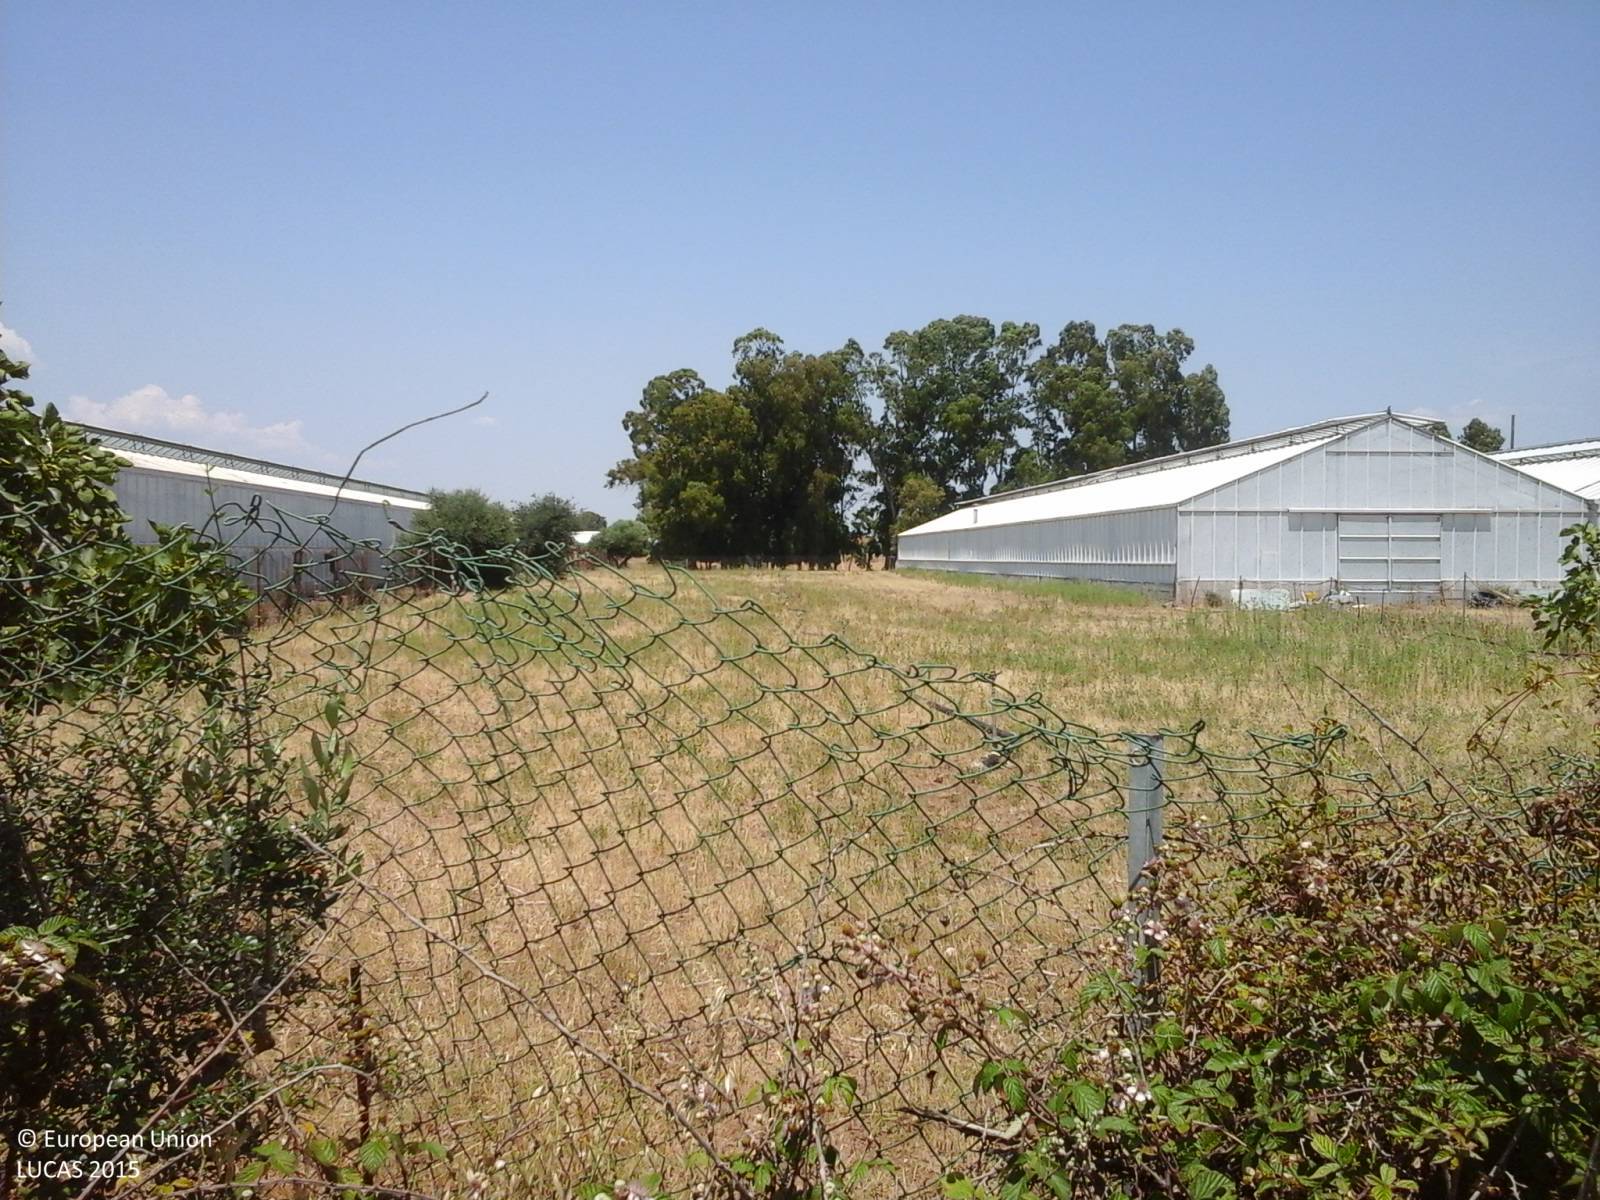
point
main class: Grassland
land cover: Grassland without tree/shrub cover
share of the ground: > 75 %
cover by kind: herbaceous plants 100 %
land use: Agriculture (excluding fallow land and kitchen gardens)
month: June
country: IT
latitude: 39.3375
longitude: 8.9045
